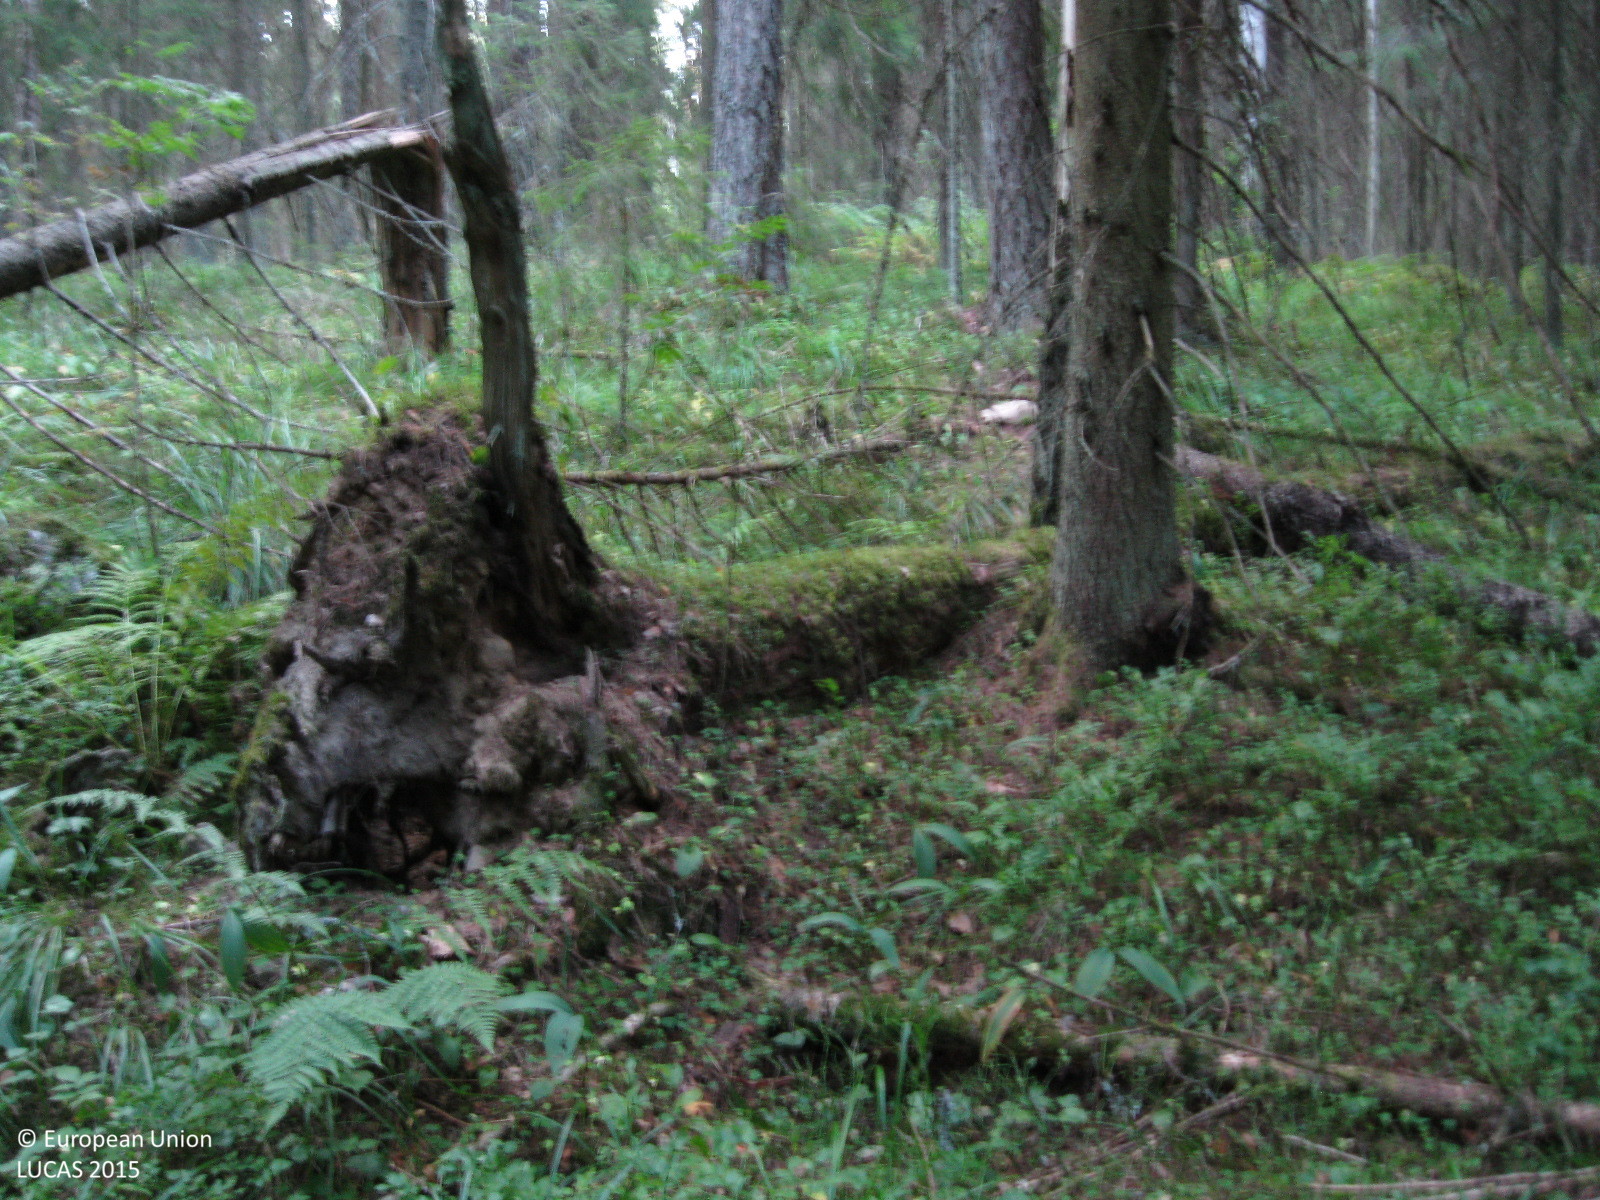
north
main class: Woodland
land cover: Other coniferous woodland
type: boreal forest
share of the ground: > 75 %
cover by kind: coniferous forest trees 85 %, herbaceous plants 10 %, broadleaved forest trees 5 %
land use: Forestry
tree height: > 5 m
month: August
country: FI
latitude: 61.3057
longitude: 25.1440
